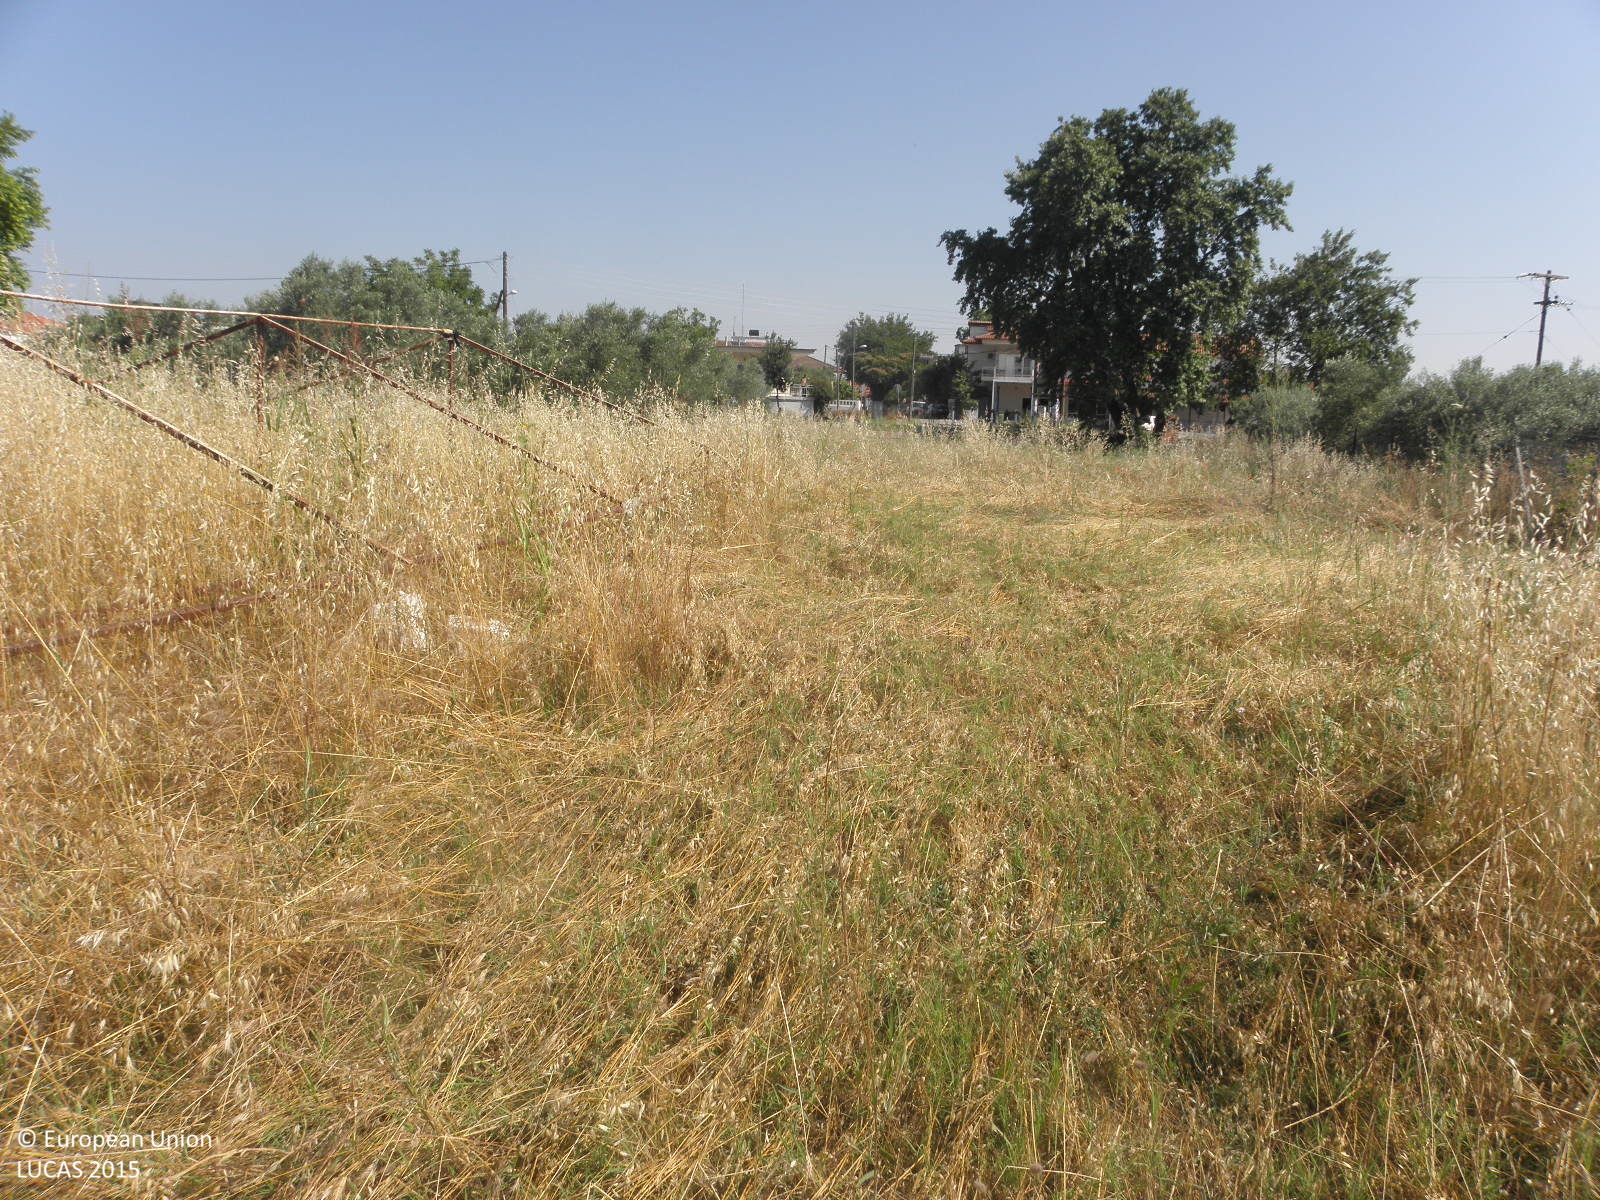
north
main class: Grassland
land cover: Spontaneously vegetated surfaces
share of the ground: > 75 %
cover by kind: herbaceous plants 100 %
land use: Fallow land
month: June
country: GR
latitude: 40.2038
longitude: 22.4381
